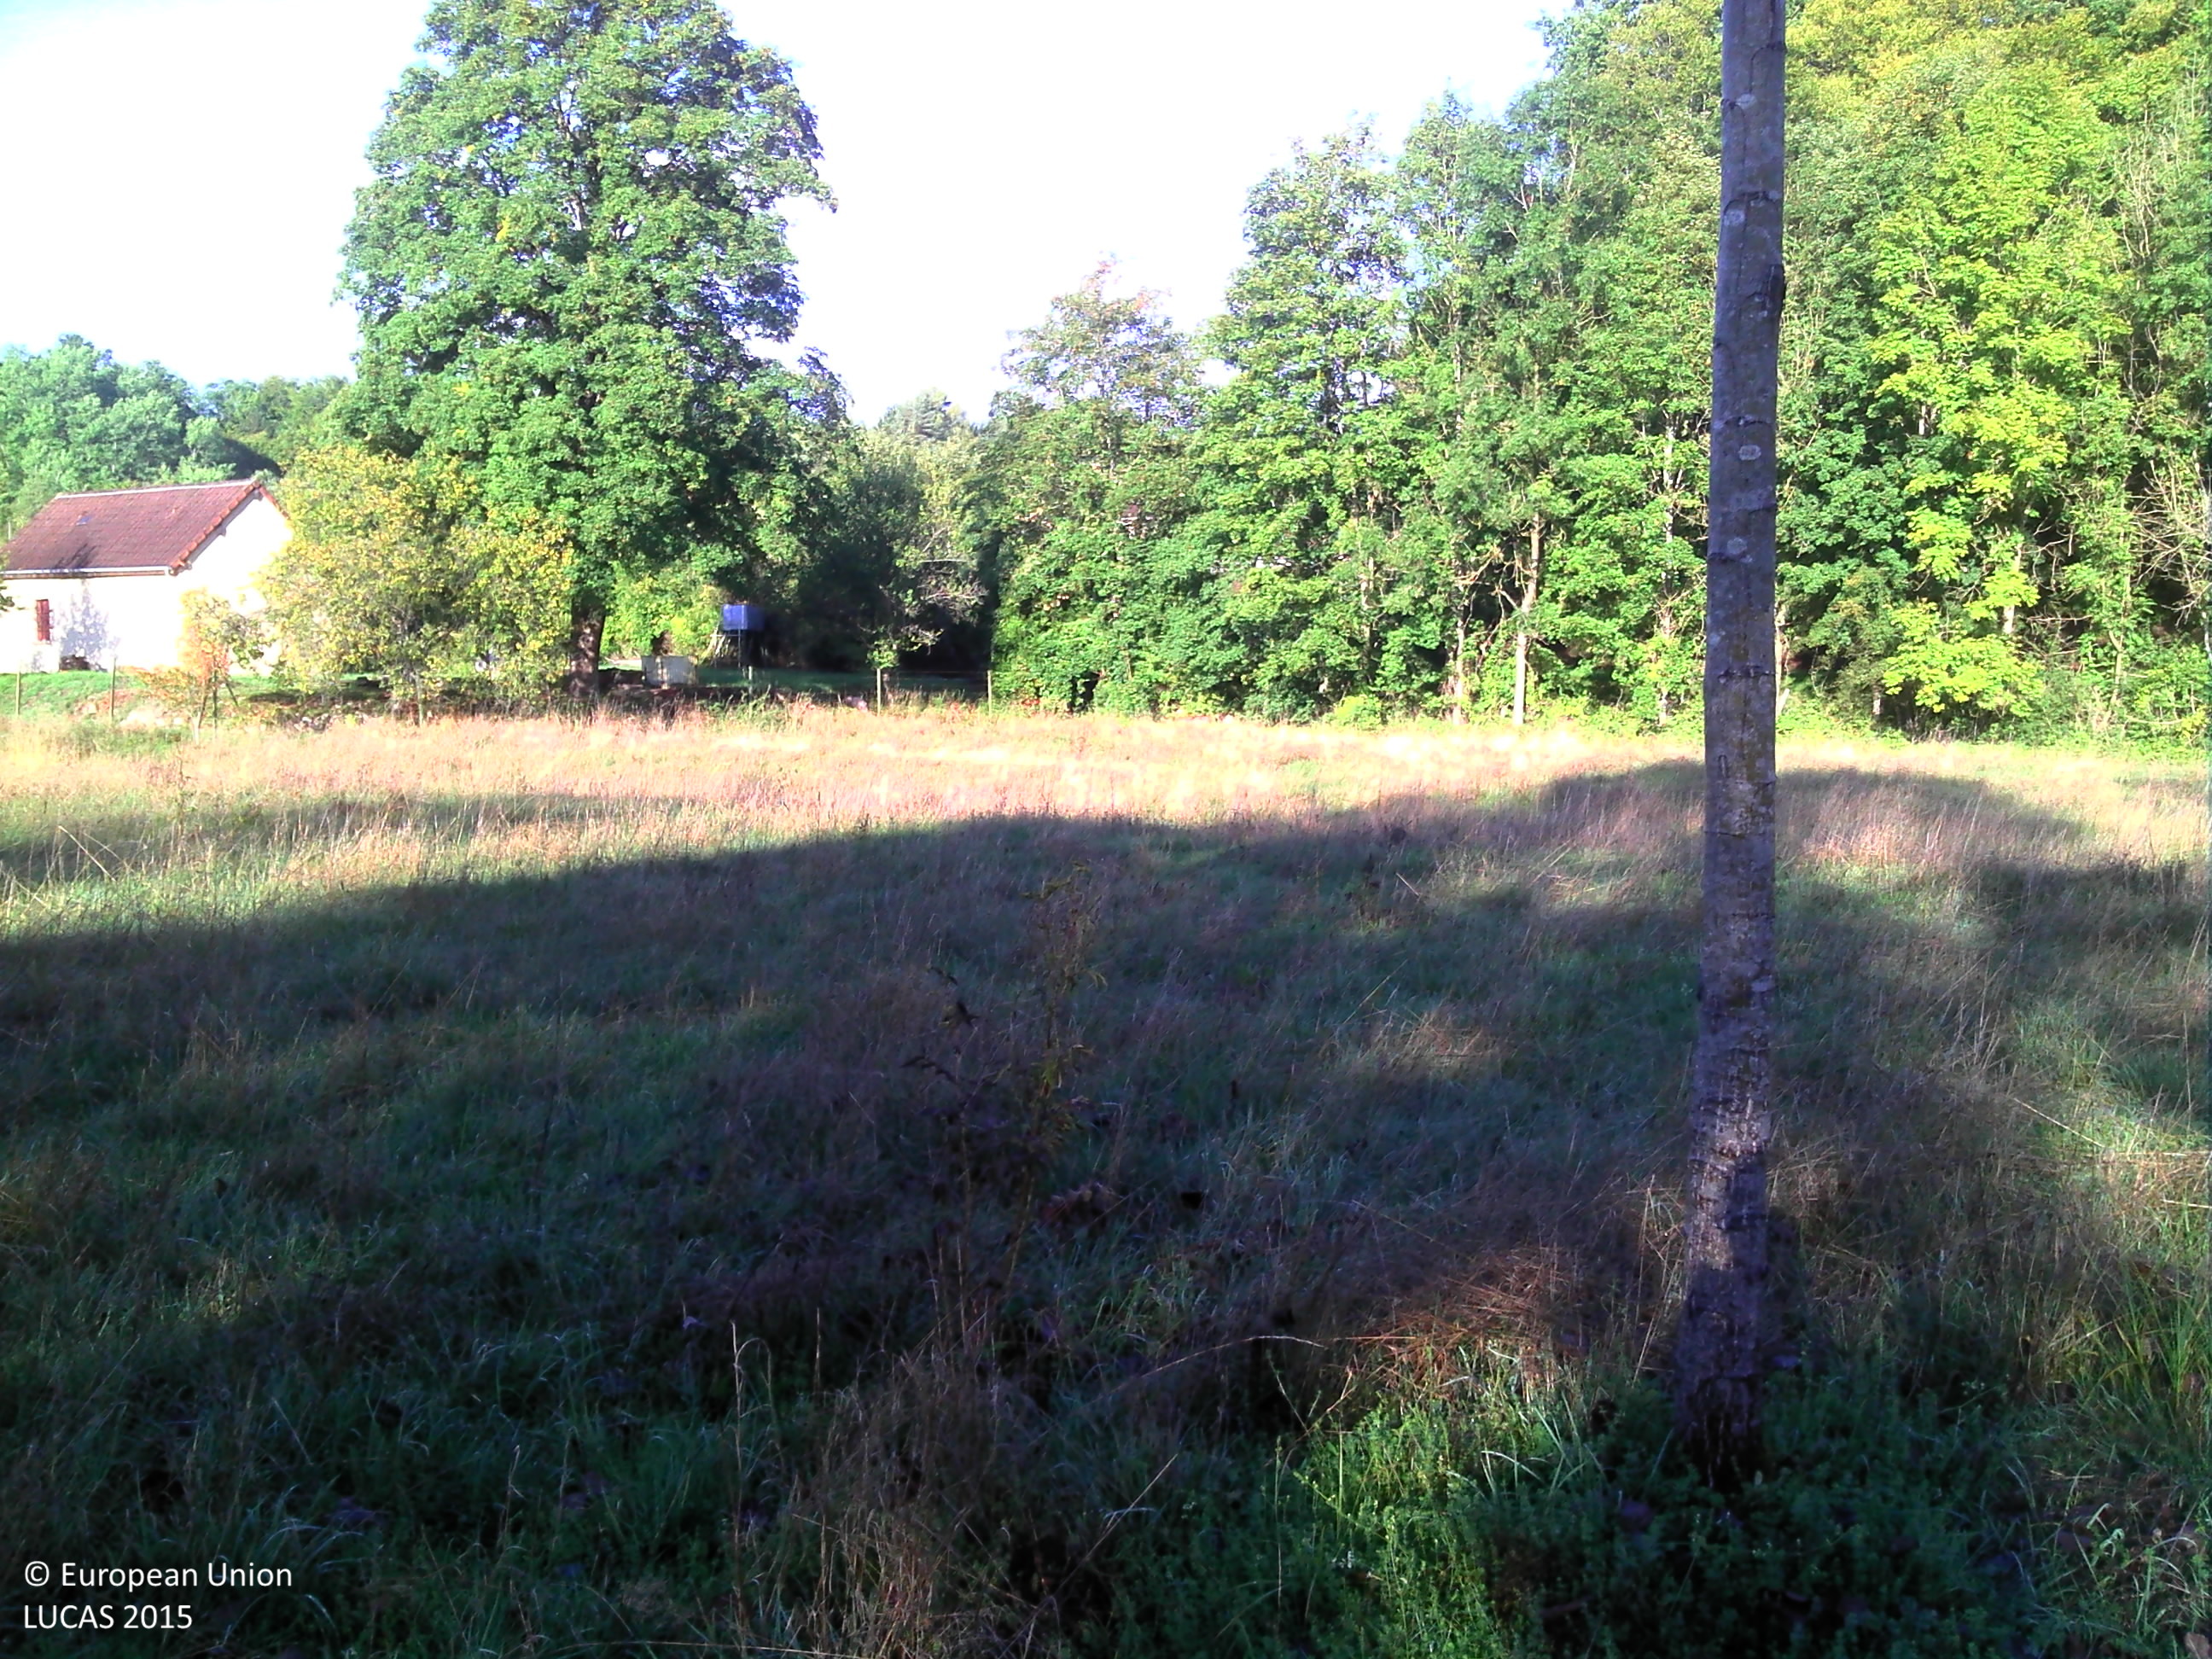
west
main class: Woodland
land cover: Broadleaved woodland
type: exotic forest
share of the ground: 25 - 50 %
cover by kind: herbaceous plants 65 %, broadleaved forest trees 35 %
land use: Forestry
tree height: > 5 m
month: September
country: FR
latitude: 48.1548
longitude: 4.7961
